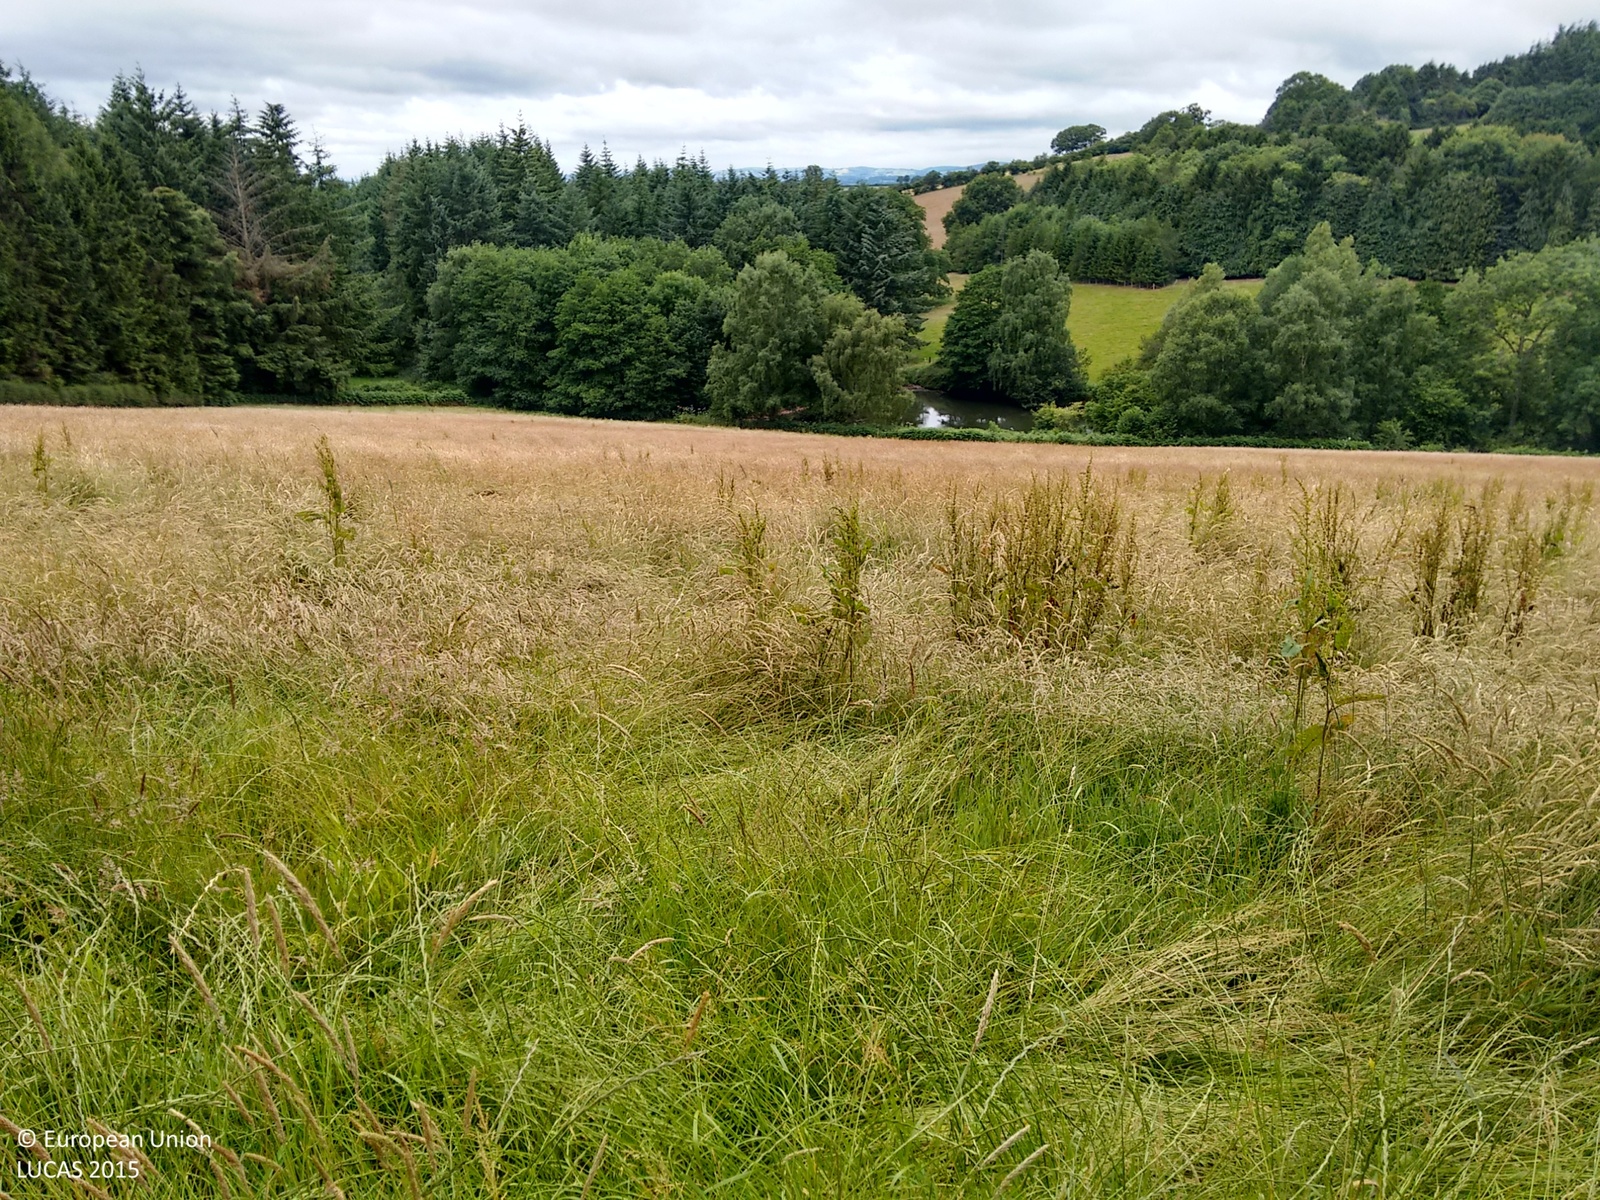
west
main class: Grassland
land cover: Grassland without tree/shrub cover
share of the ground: > 75 %
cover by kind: herbaceous plants 100 %
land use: Agriculture (excluding fallow land and kitchen gardens)
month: July
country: GB
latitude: 52.2259
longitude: -2.6444
